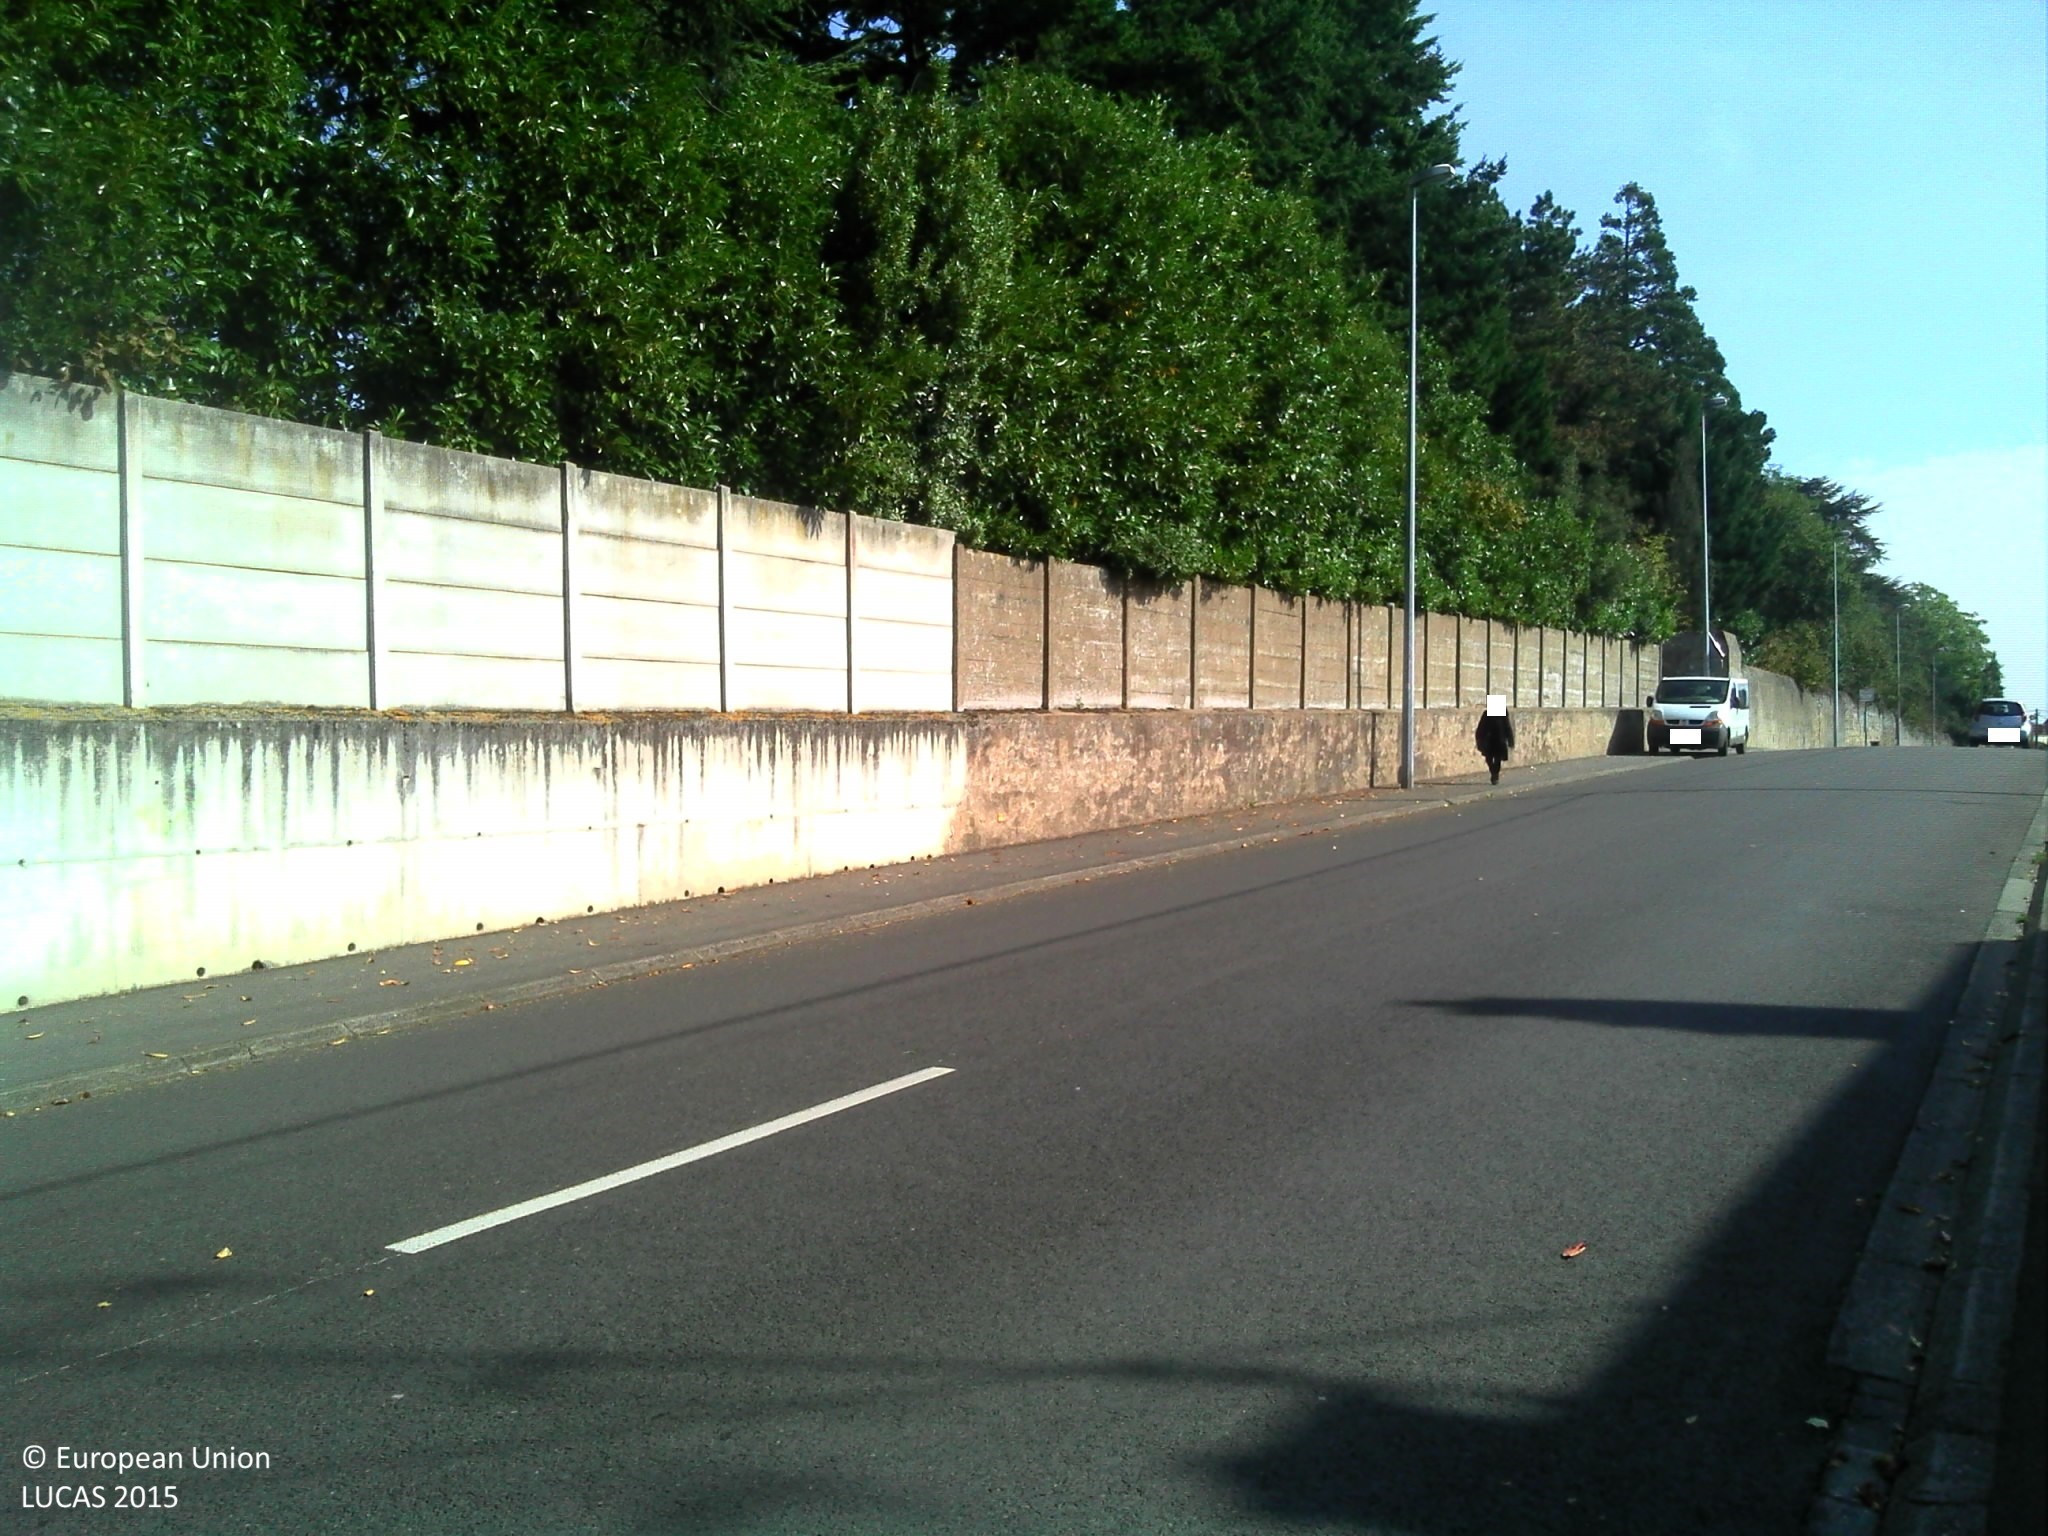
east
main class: Woodland
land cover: Other mixed woodland
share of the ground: > 75 %
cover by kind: coniferous forest trees 65 %, broadleaved forest trees 25 %, herbaceous plants 10 %
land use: Residential
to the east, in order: Other mixed woodland; Grassland without tree/shrub cover; Broadleaved woodland; Artificial constructions in urban areas
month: October
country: FR
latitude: 47.0644
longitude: -0.8961
